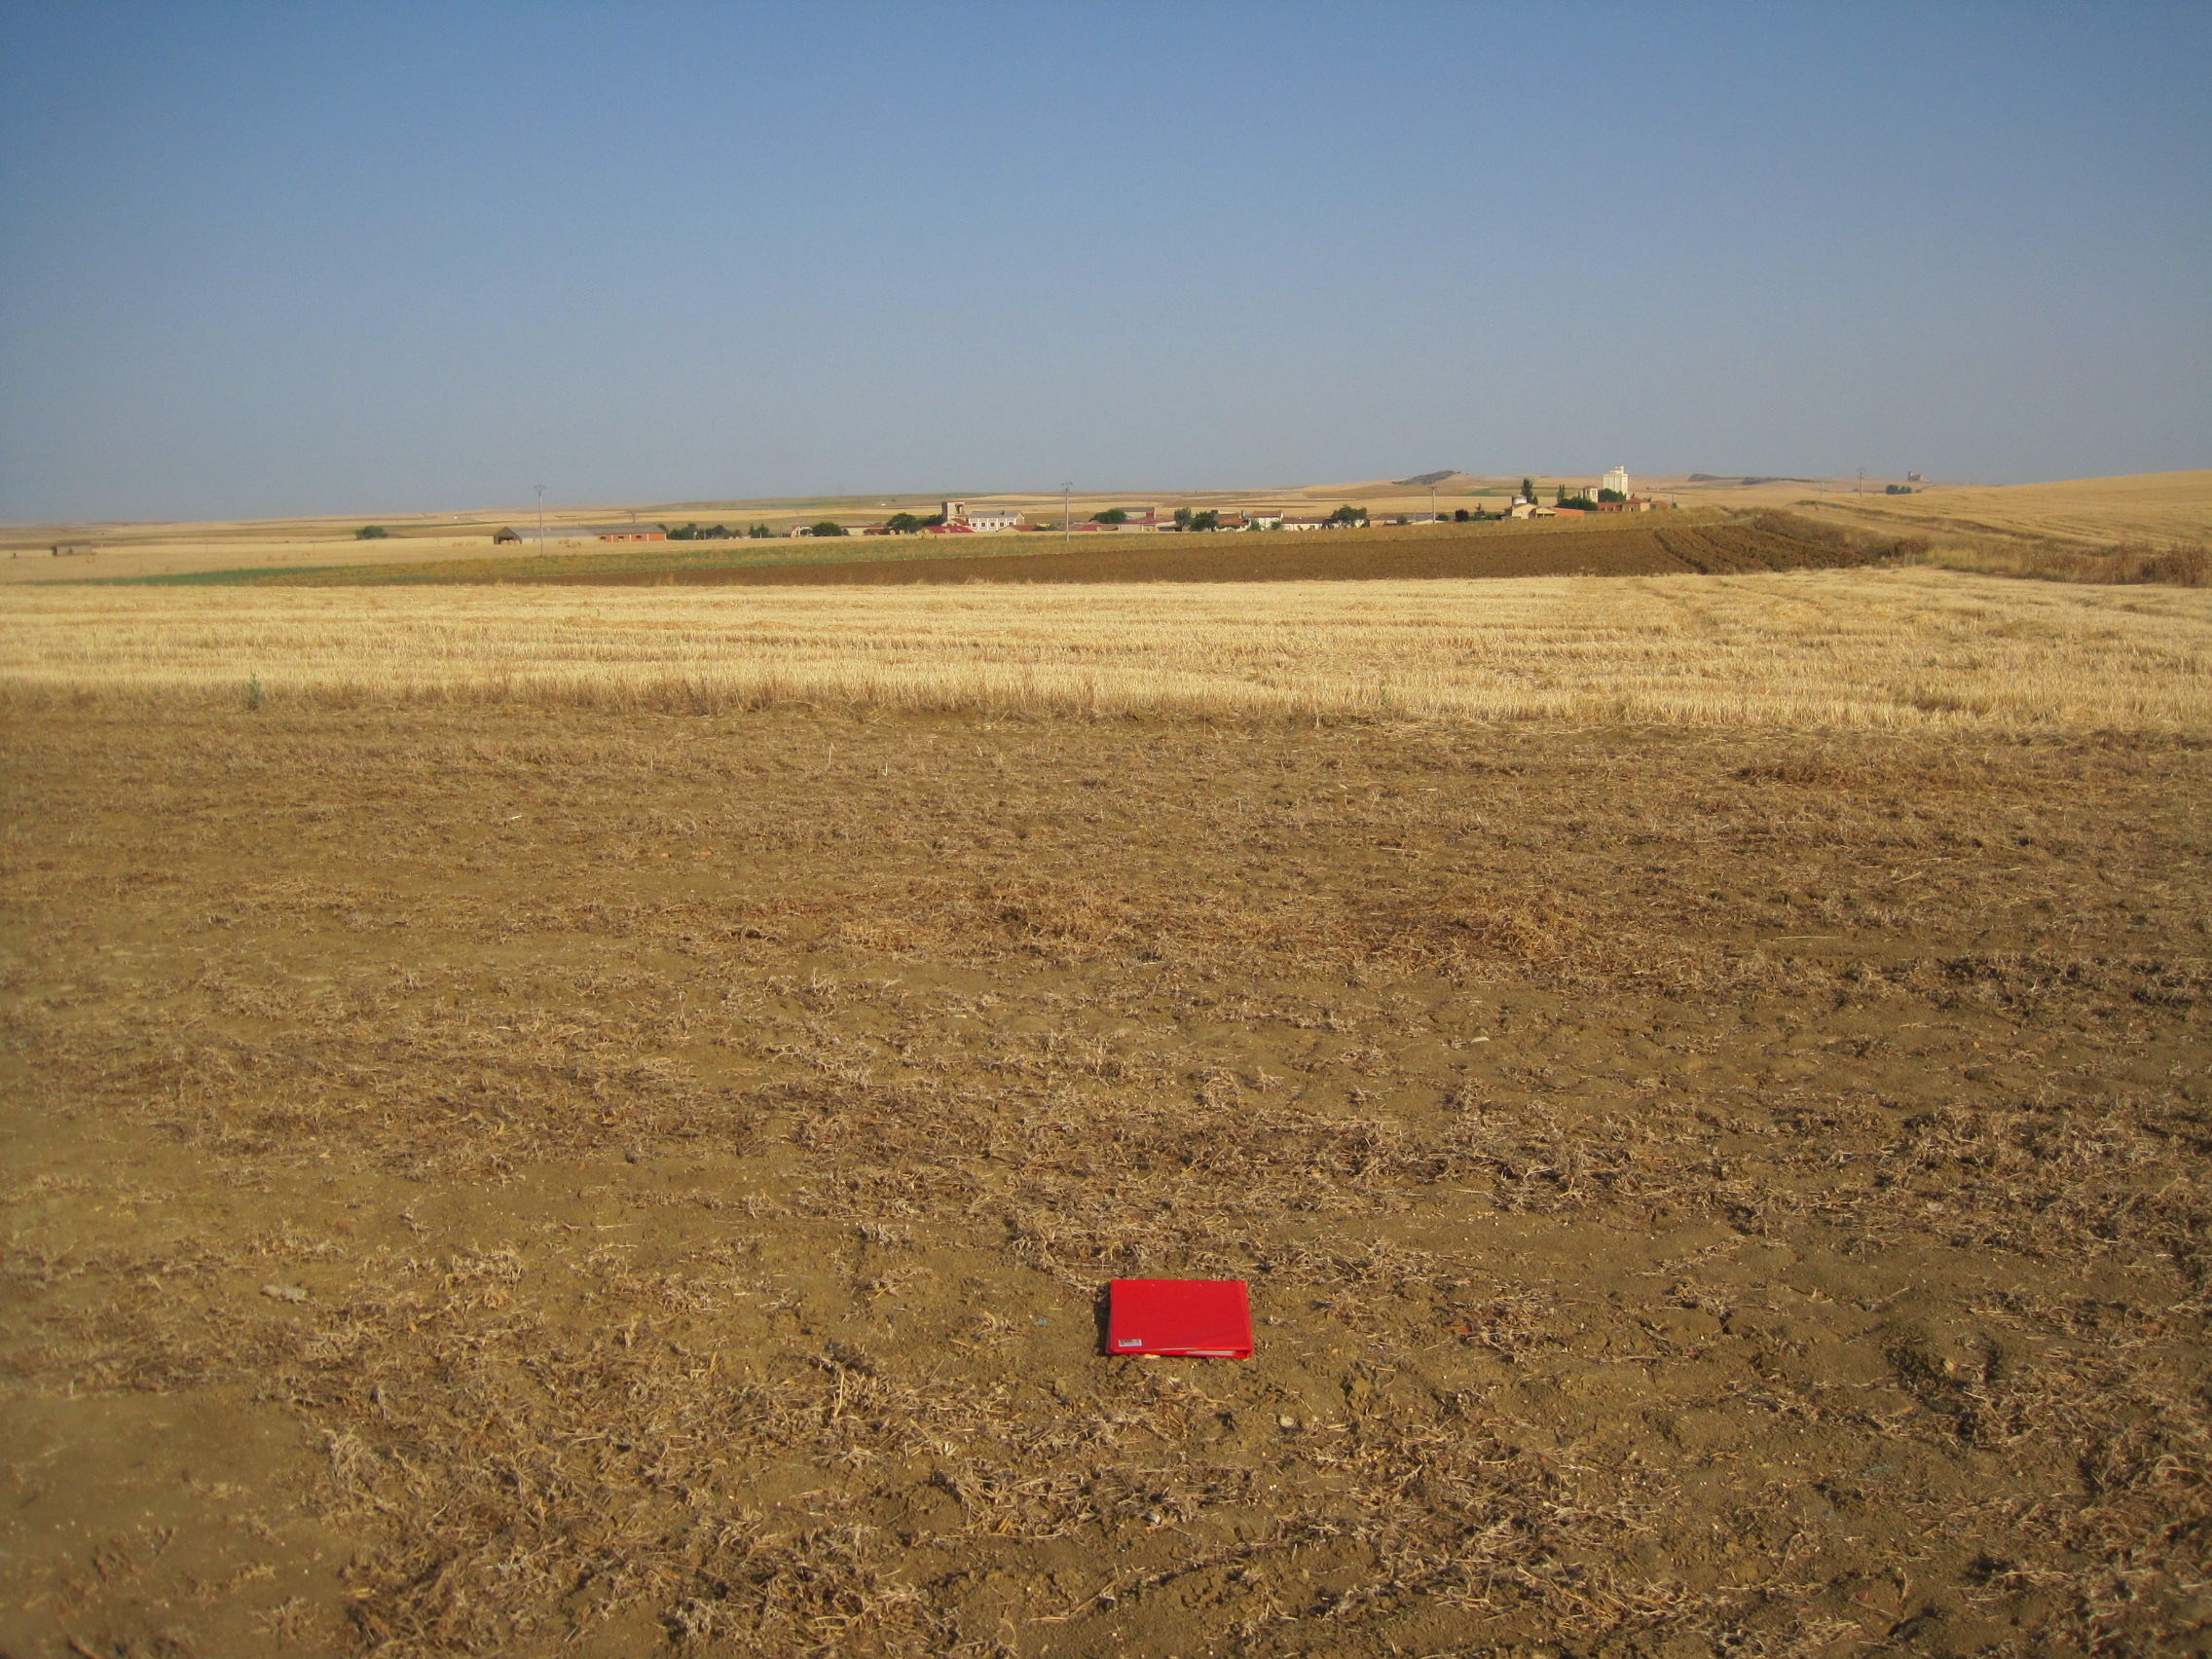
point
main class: Cropland
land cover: Dry pulses
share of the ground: < 10 %
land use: Agriculture (excluding fallow land and kitchen gardens)
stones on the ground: < 10 %
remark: Harvested field
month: July
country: ES
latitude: 41.5927
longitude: -5.4249
